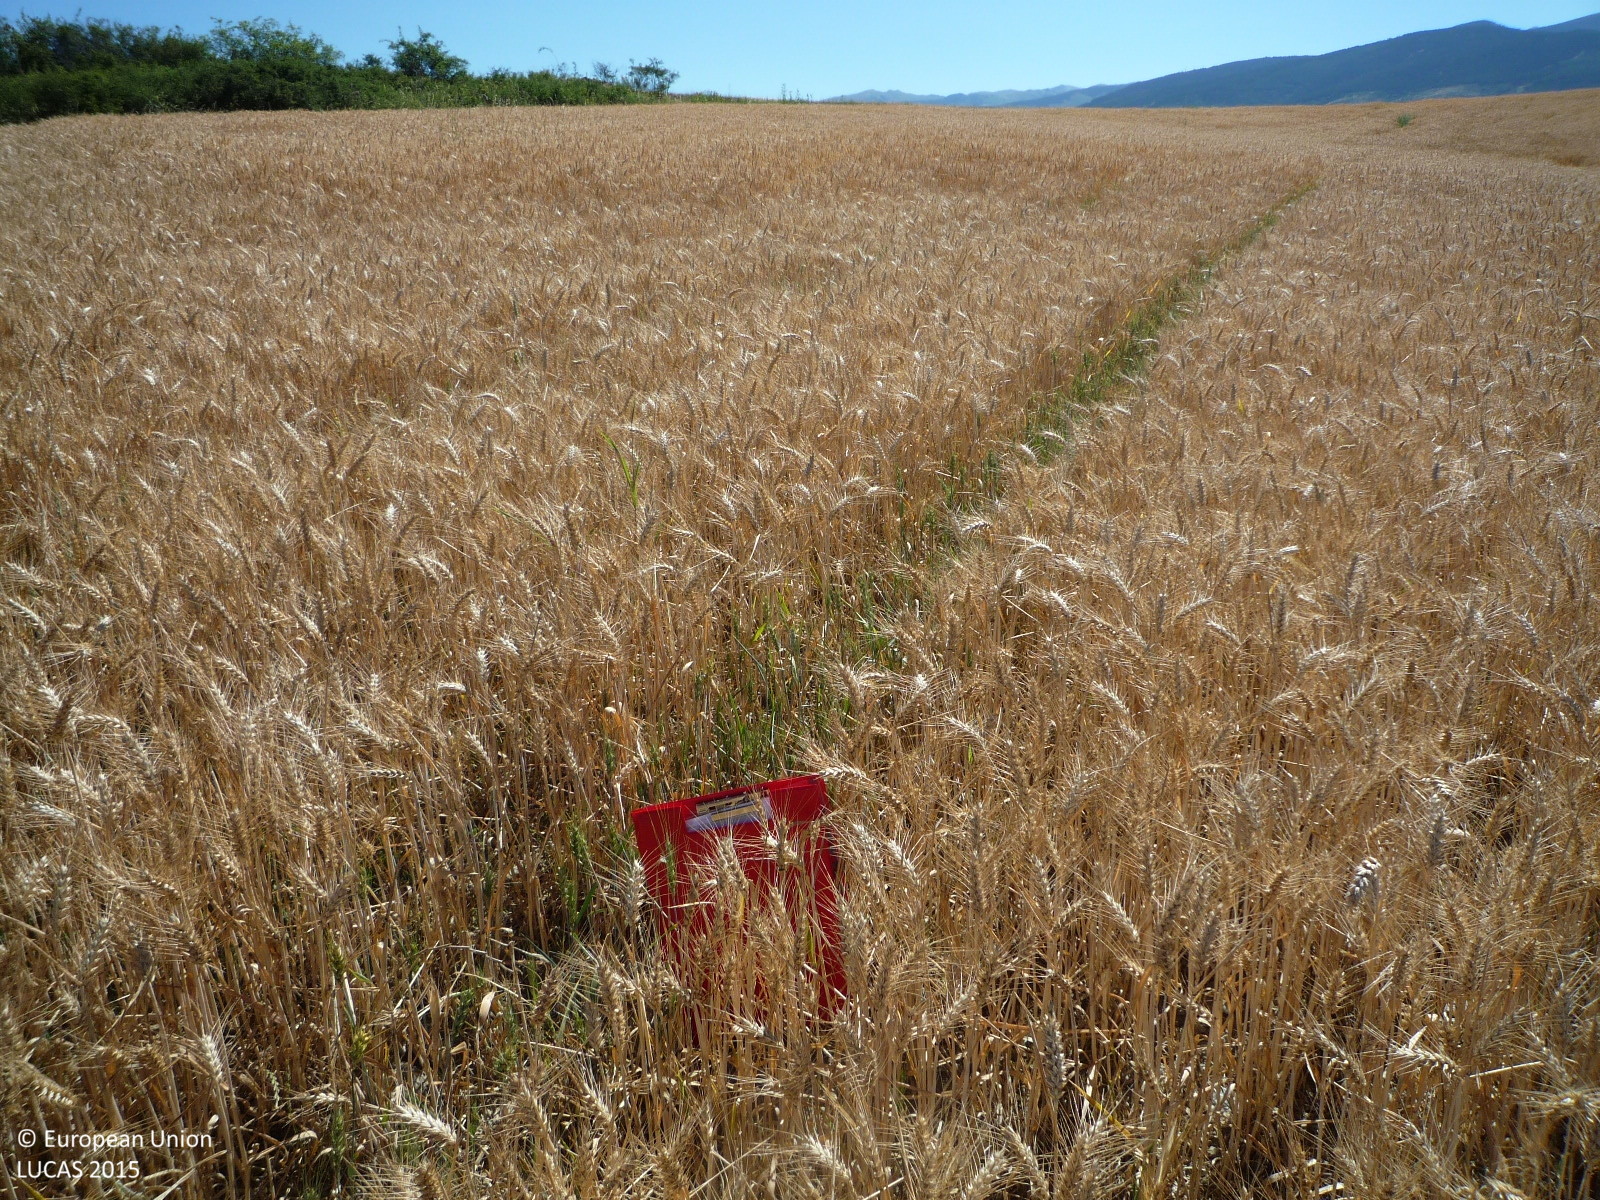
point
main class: Cropland
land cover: Common wheat
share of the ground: > 75 %
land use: Agriculture (excluding fallow land and kitchen gardens)
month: July
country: ES
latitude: 42.4242
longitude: 1.9532
